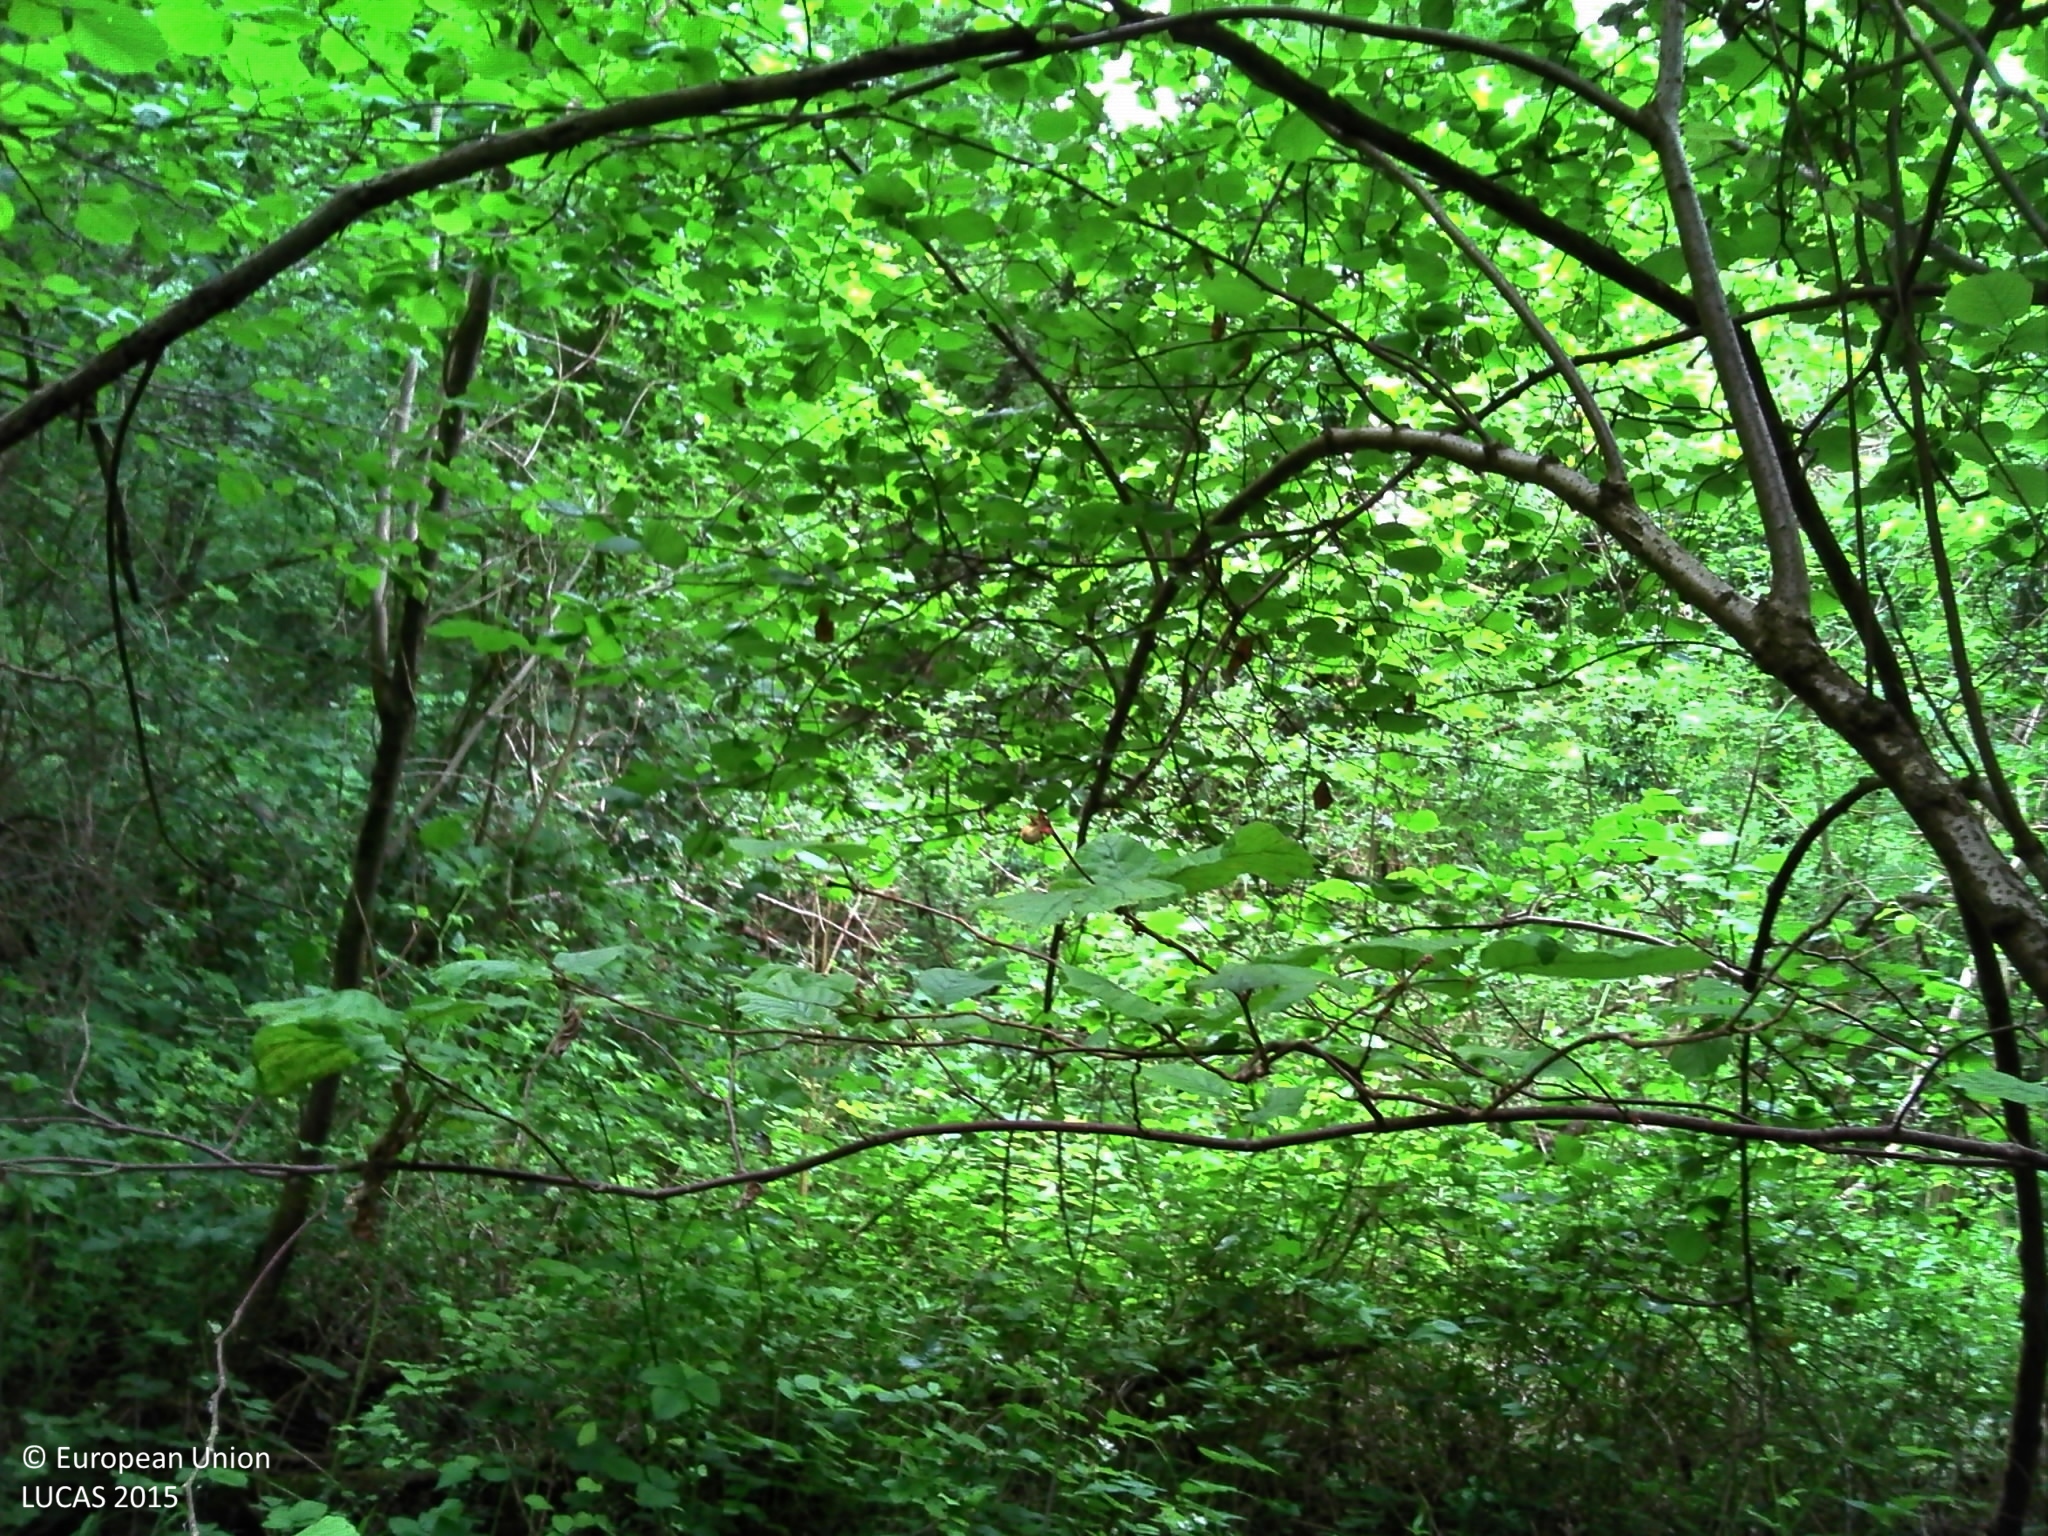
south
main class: Woodland
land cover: Broadleaved woodland
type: mesophytic deciduous forest
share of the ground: > 75 %
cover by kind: broadleaved forest trees 85 %, shrubs 10 %, herbaceous plants 5 %
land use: Forestry
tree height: > 5 m
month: June
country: FR
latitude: 49.2613
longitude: 2.9414
